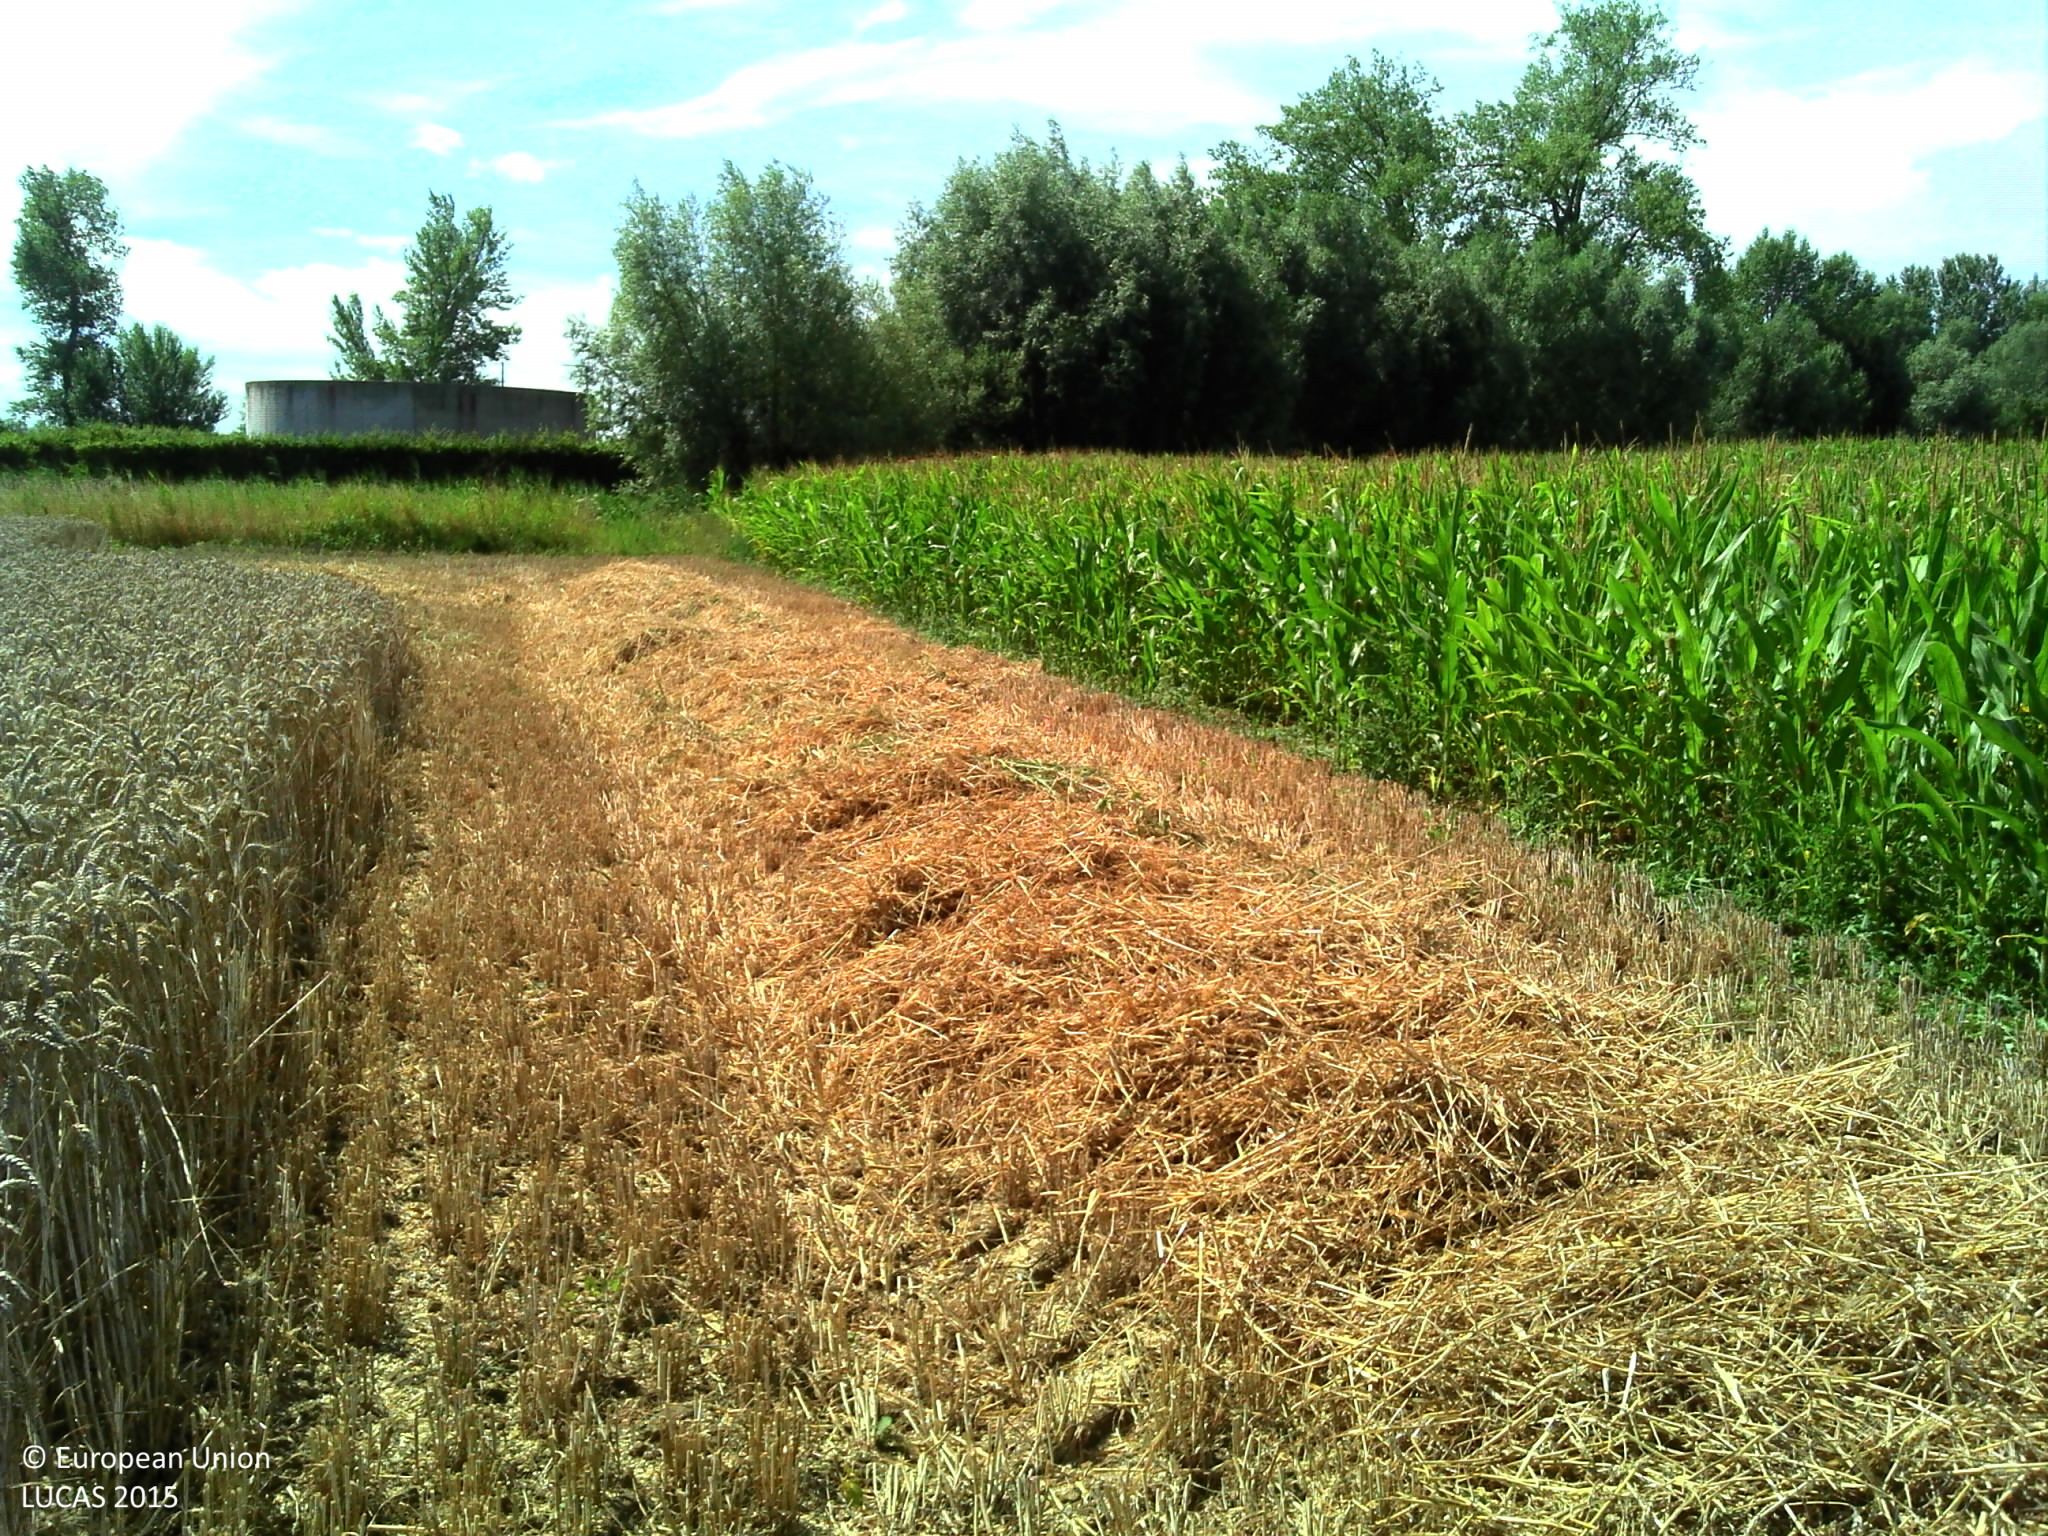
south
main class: Cropland
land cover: Common wheat
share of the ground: > 75 %
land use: Agriculture (excluding fallow land and kitchen gardens)
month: August
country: FR
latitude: 50.6560
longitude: 2.4476
